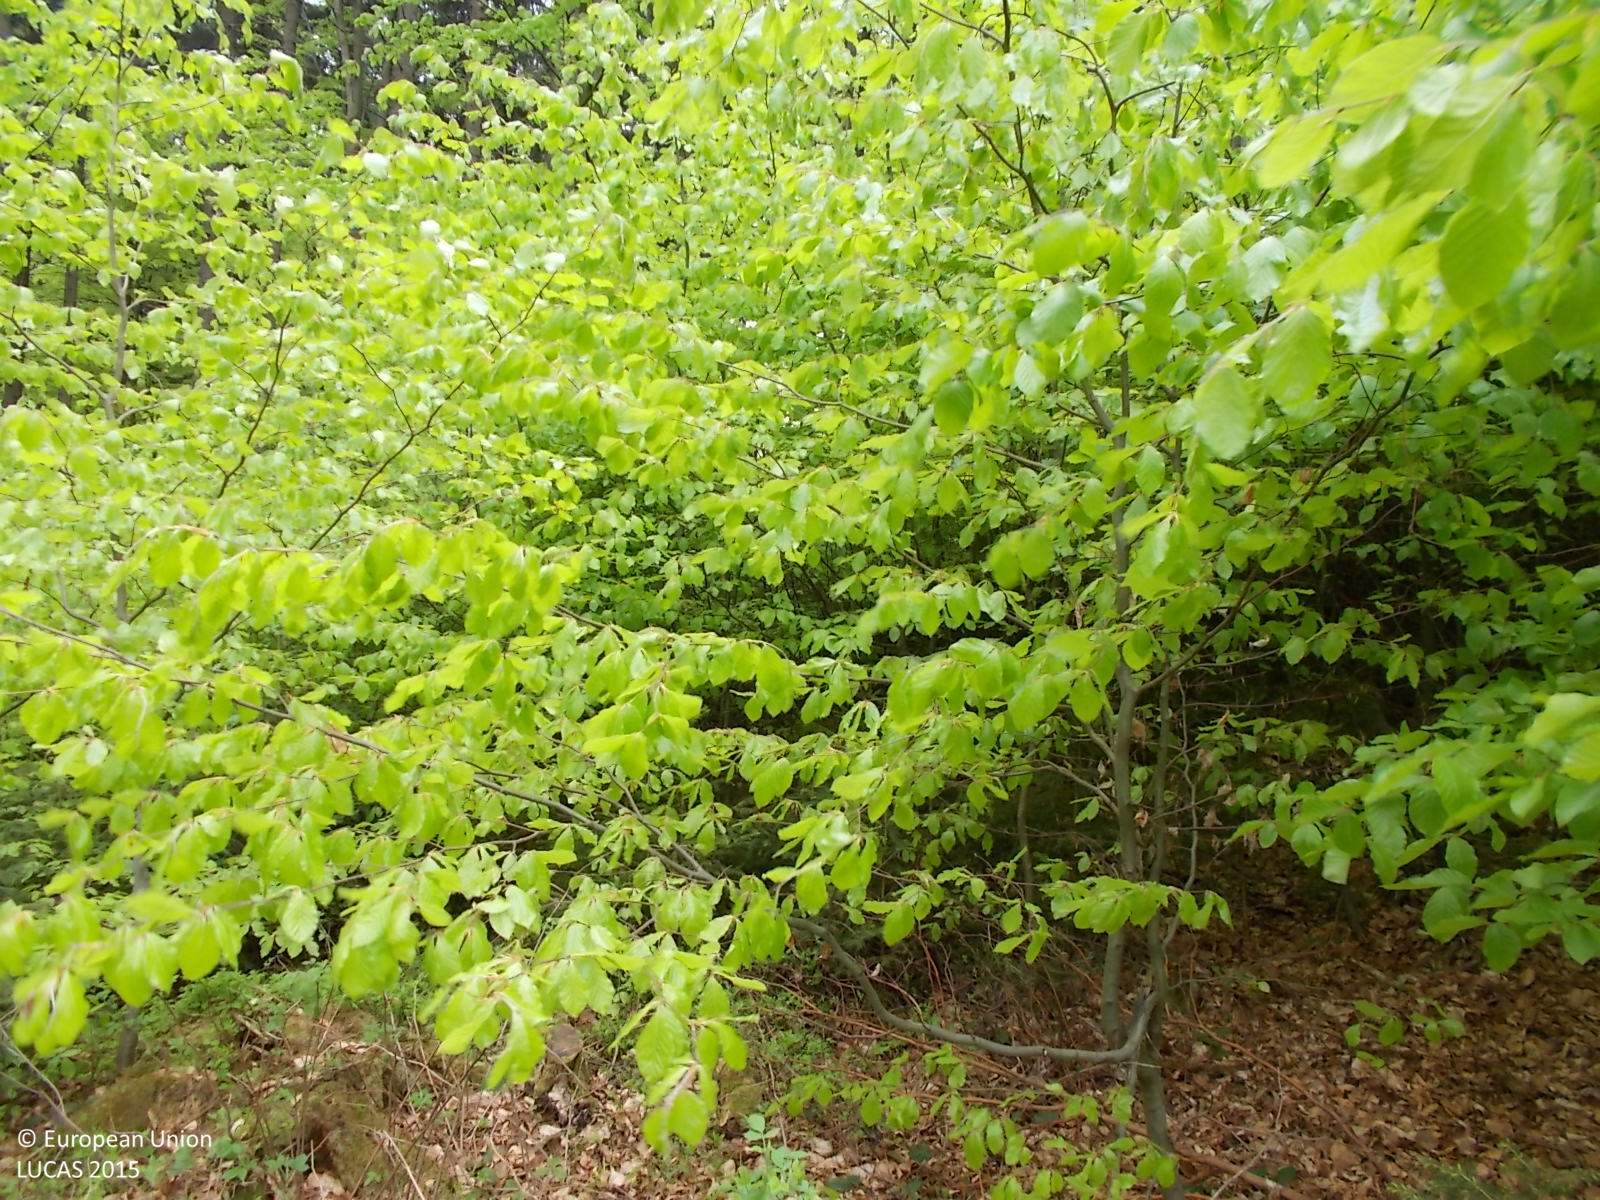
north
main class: Woodland
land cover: Other coniferous woodland
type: hemiboreal forest and nemoral coniferous forest and mixed broadleaved-coniferous forest
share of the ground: > 75 %
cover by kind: coniferous forest trees 70 %, broadleaved forest trees 20 %, herbaceous plants 5 %, lichens and mosses 5 %
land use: Forestry
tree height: > 5 m
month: May
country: CZ
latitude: 49.4742
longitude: 15.5102
